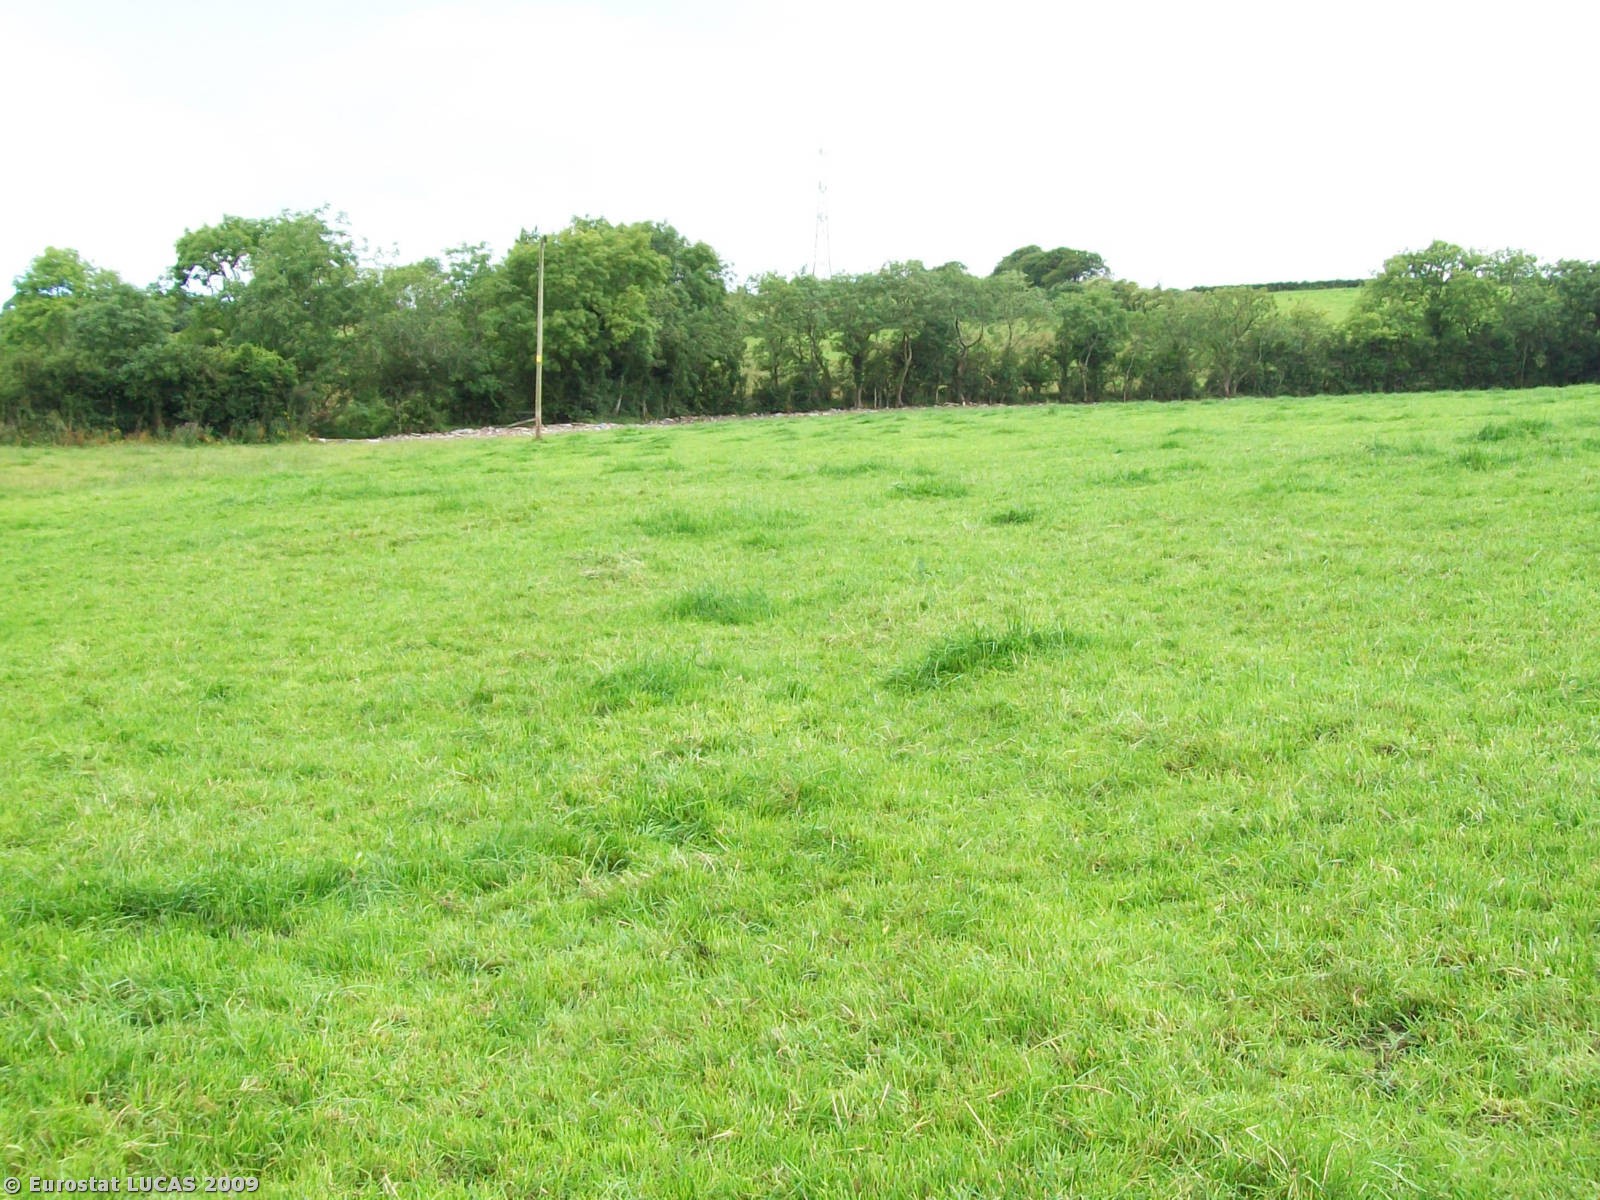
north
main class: Grassland
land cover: Grassland without tree/shrub cover
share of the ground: > 75 %
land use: Agriculture (excluding fallow land and kitchen gardens)
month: July
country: GB
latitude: 54.7357
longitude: -5.8376
